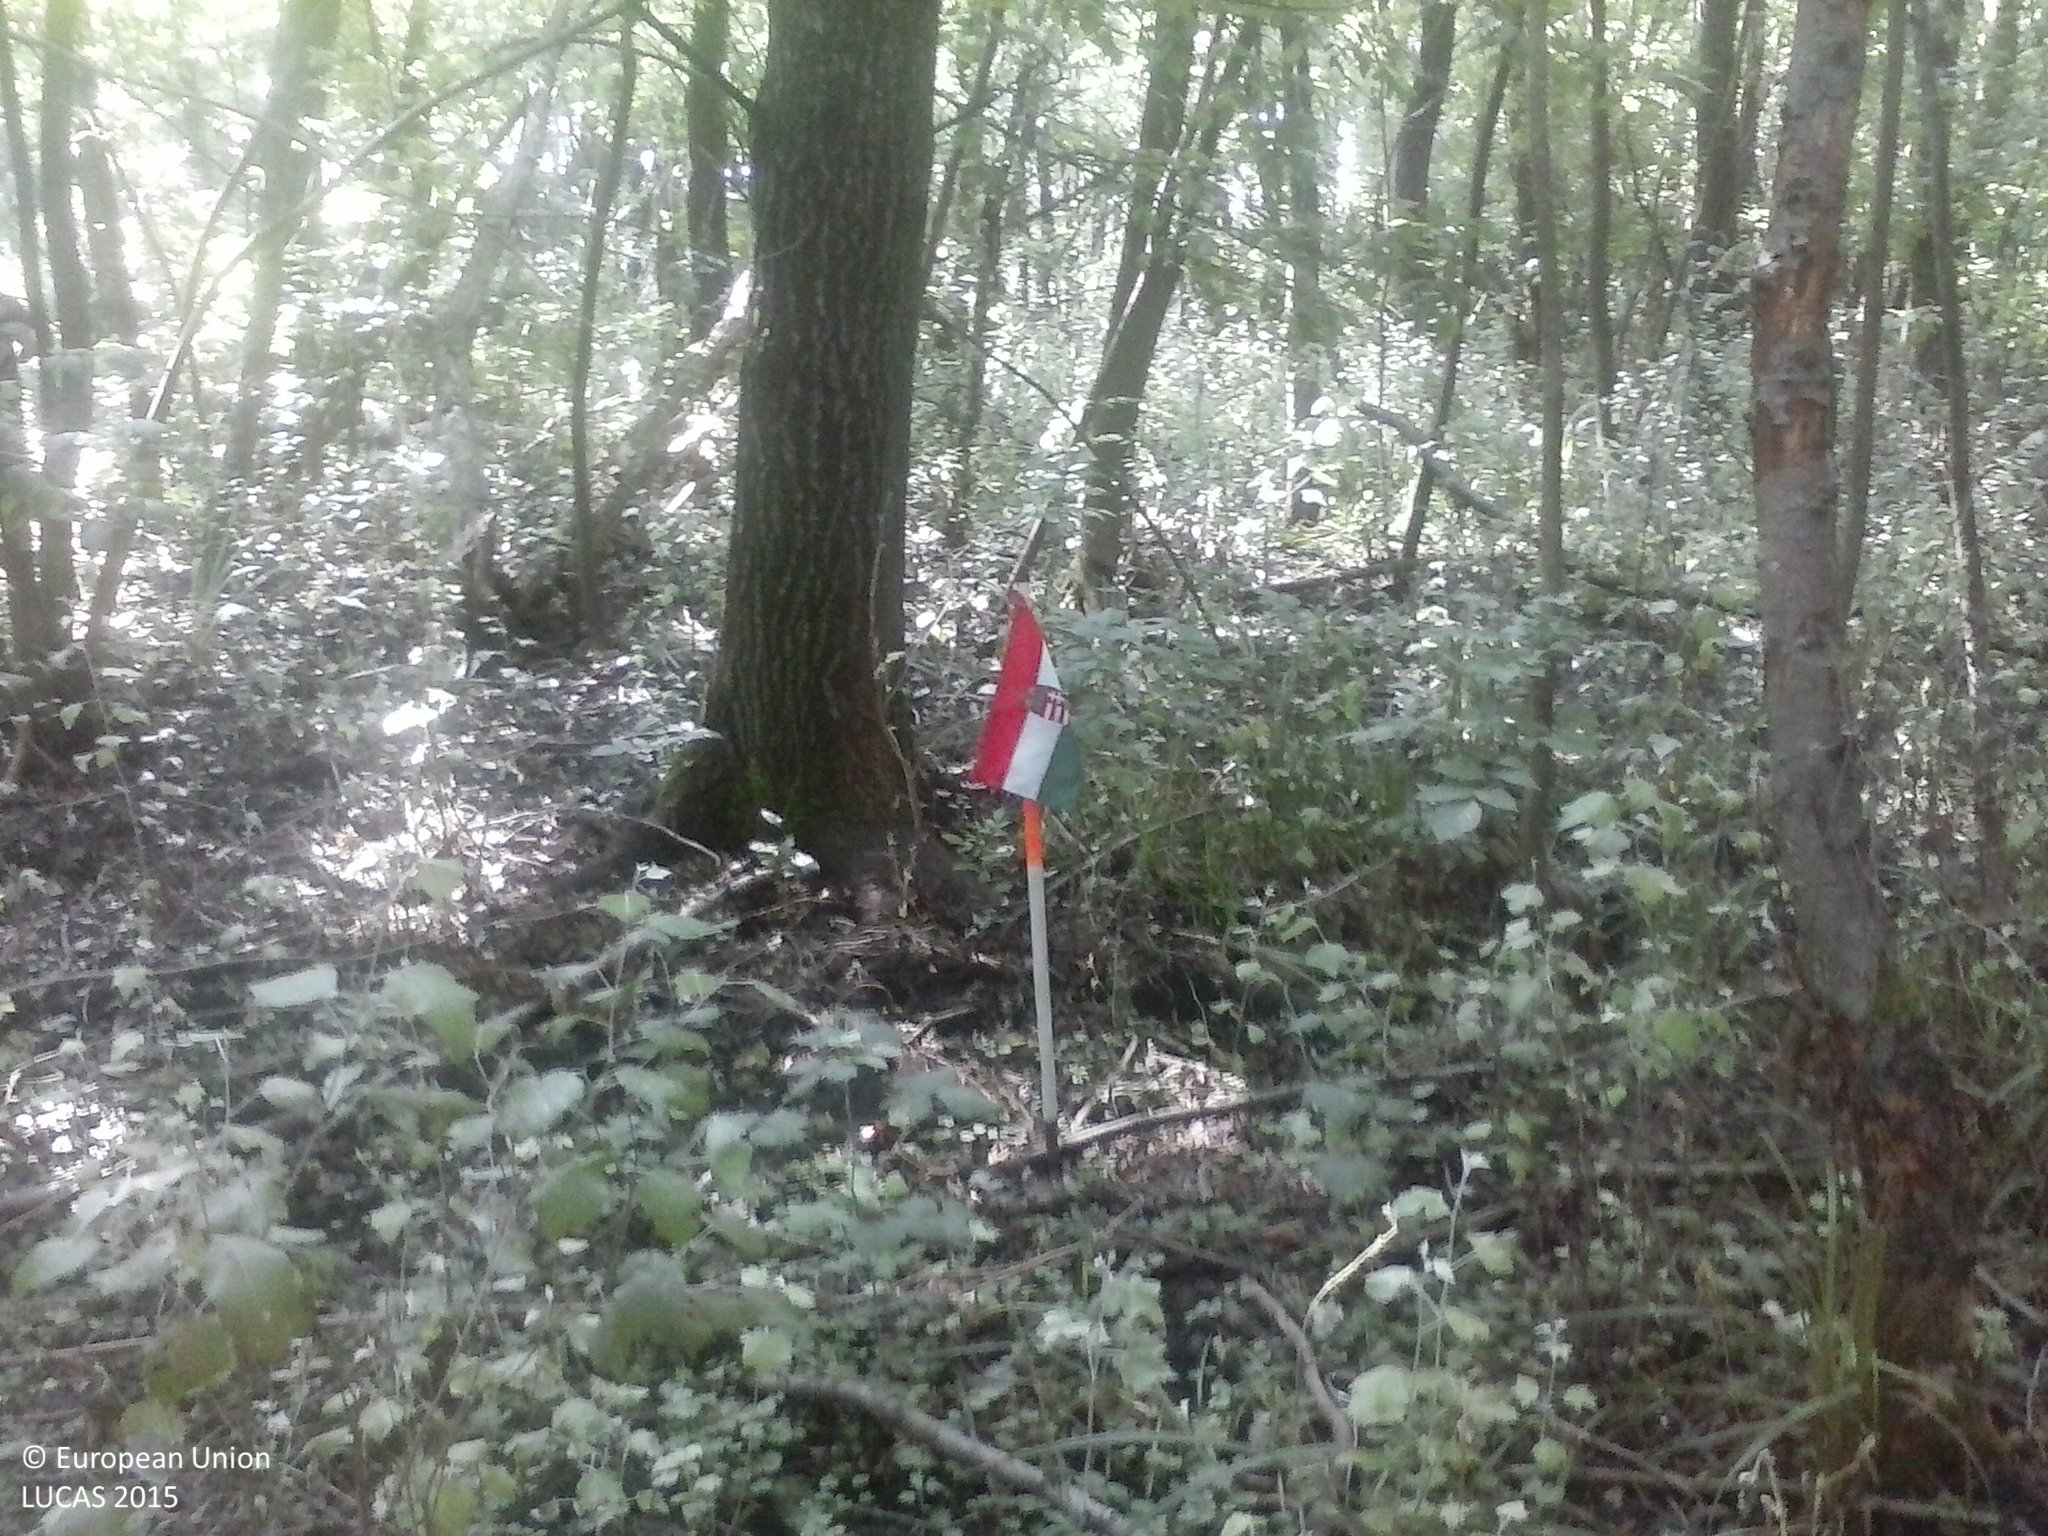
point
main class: Woodland
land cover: Broadleaved woodland
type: thermophilous deciduous forest
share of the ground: > 75 %
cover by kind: broadleaved forest trees 90 %, shrubs 5 %, herbaceous plants 5 %
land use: Forestry
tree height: > 5 m
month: August
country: HU
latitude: 45.8512
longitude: 17.7694
